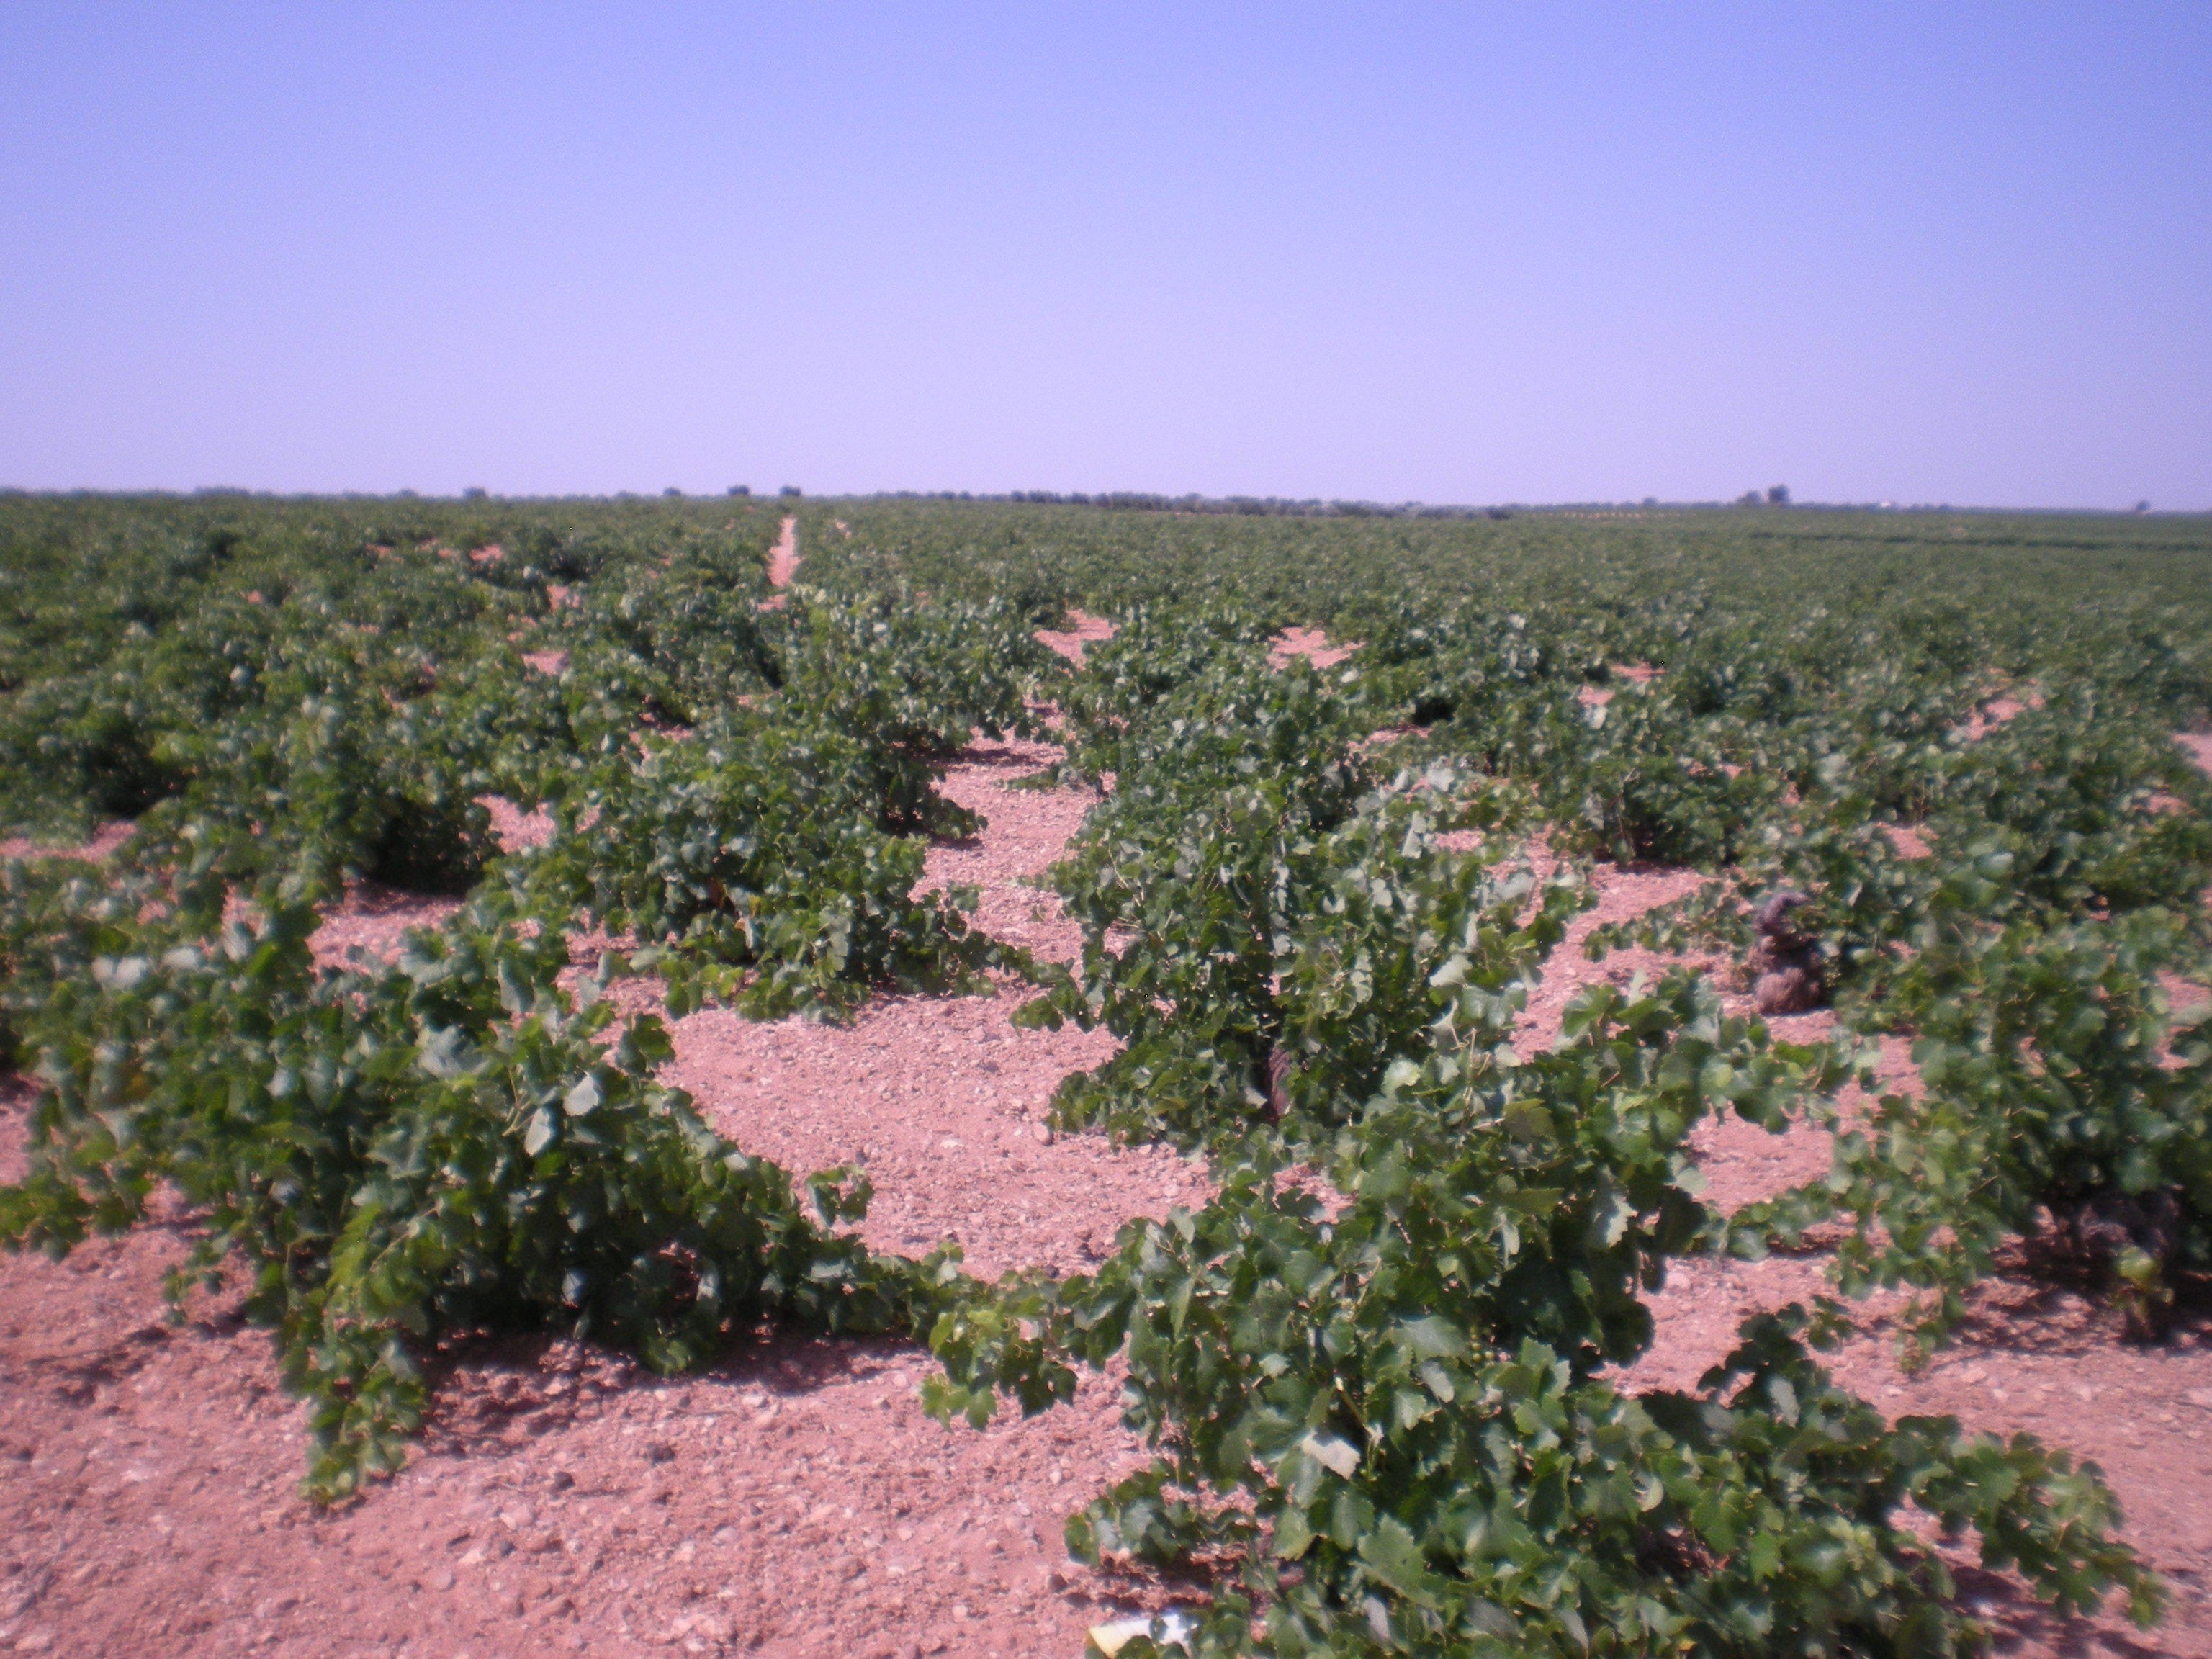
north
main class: Cropland
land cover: Vineyards
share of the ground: 25 - 50 %
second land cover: Other bare soil
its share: > 75 %
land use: Agriculture (excluding fallow land and kitchen gardens)
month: July
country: ES
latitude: 39.5691
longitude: -3.0912
